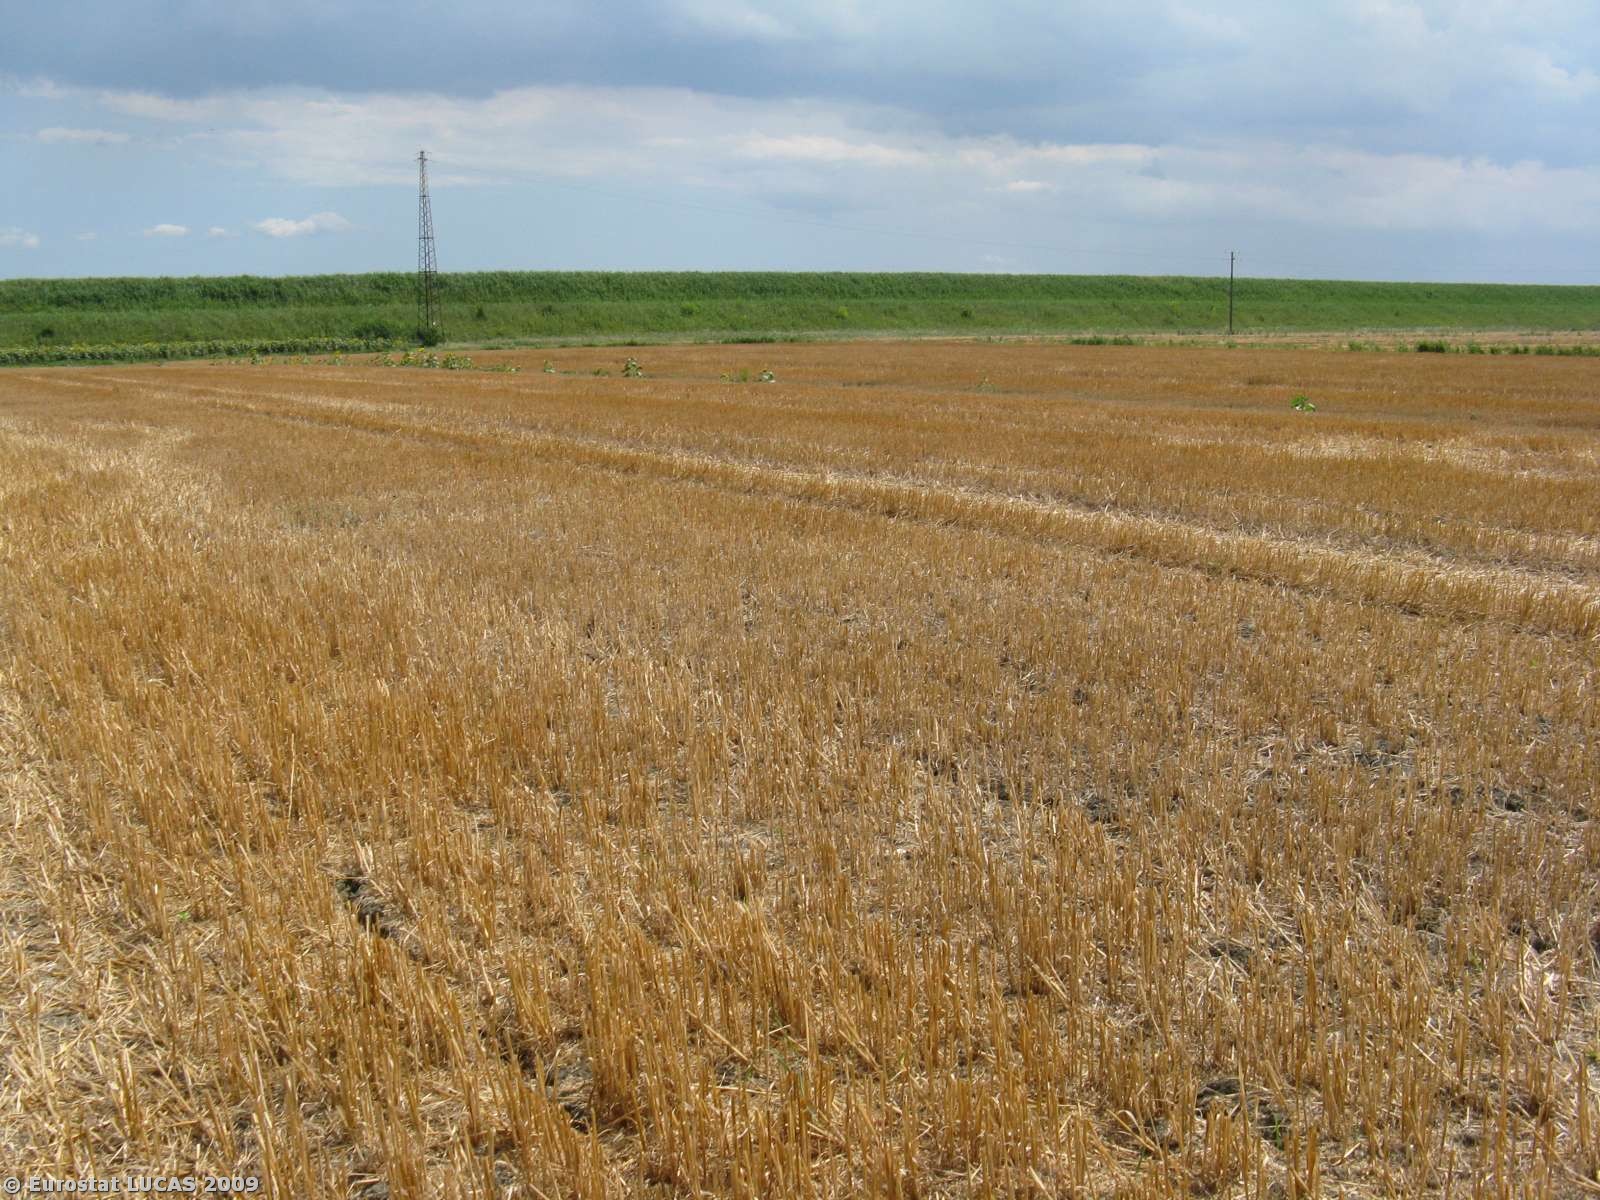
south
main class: Cropland
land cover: Common wheat
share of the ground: < 10 %
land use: Agriculture (excluding fallow land and kitchen gardens)
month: July
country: IT
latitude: 44.5540
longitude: 11.6456
